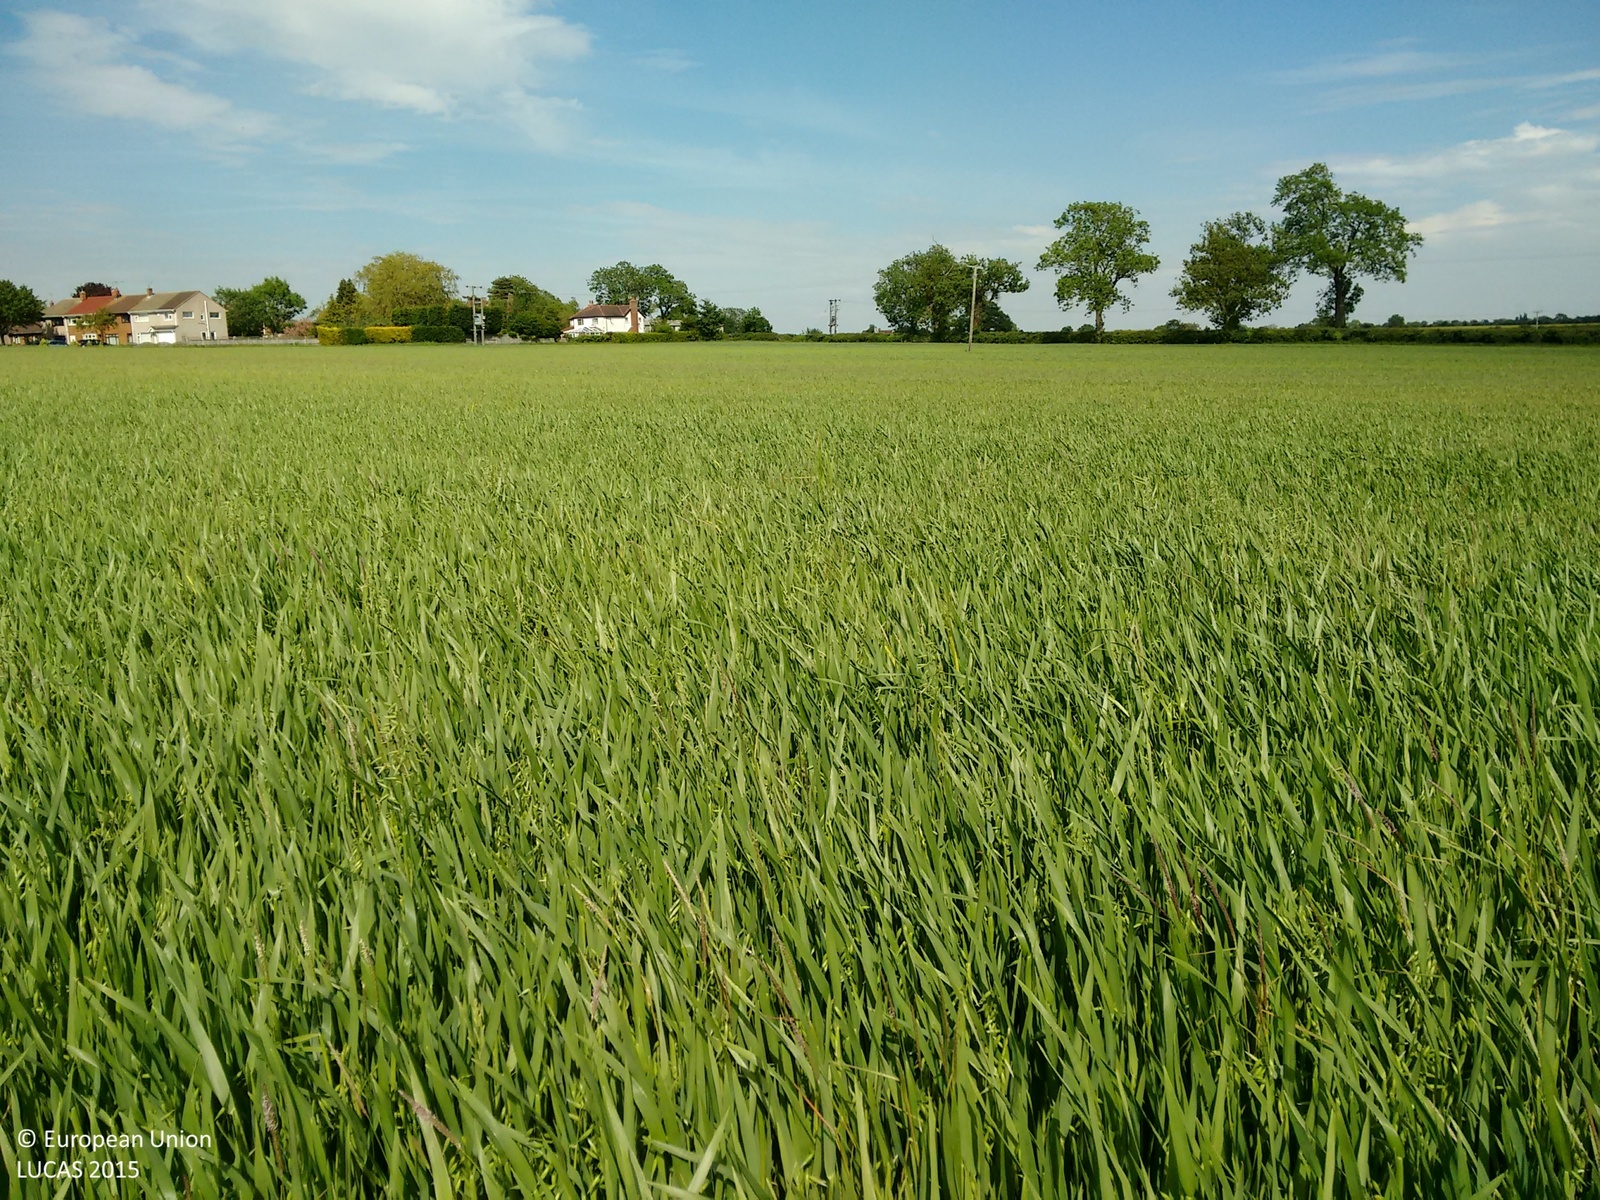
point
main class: Cropland
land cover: Oats
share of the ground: > 75 %
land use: Agriculture (excluding fallow land and kitchen gardens)
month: June
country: GB
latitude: 52.4827
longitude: -1.3727
